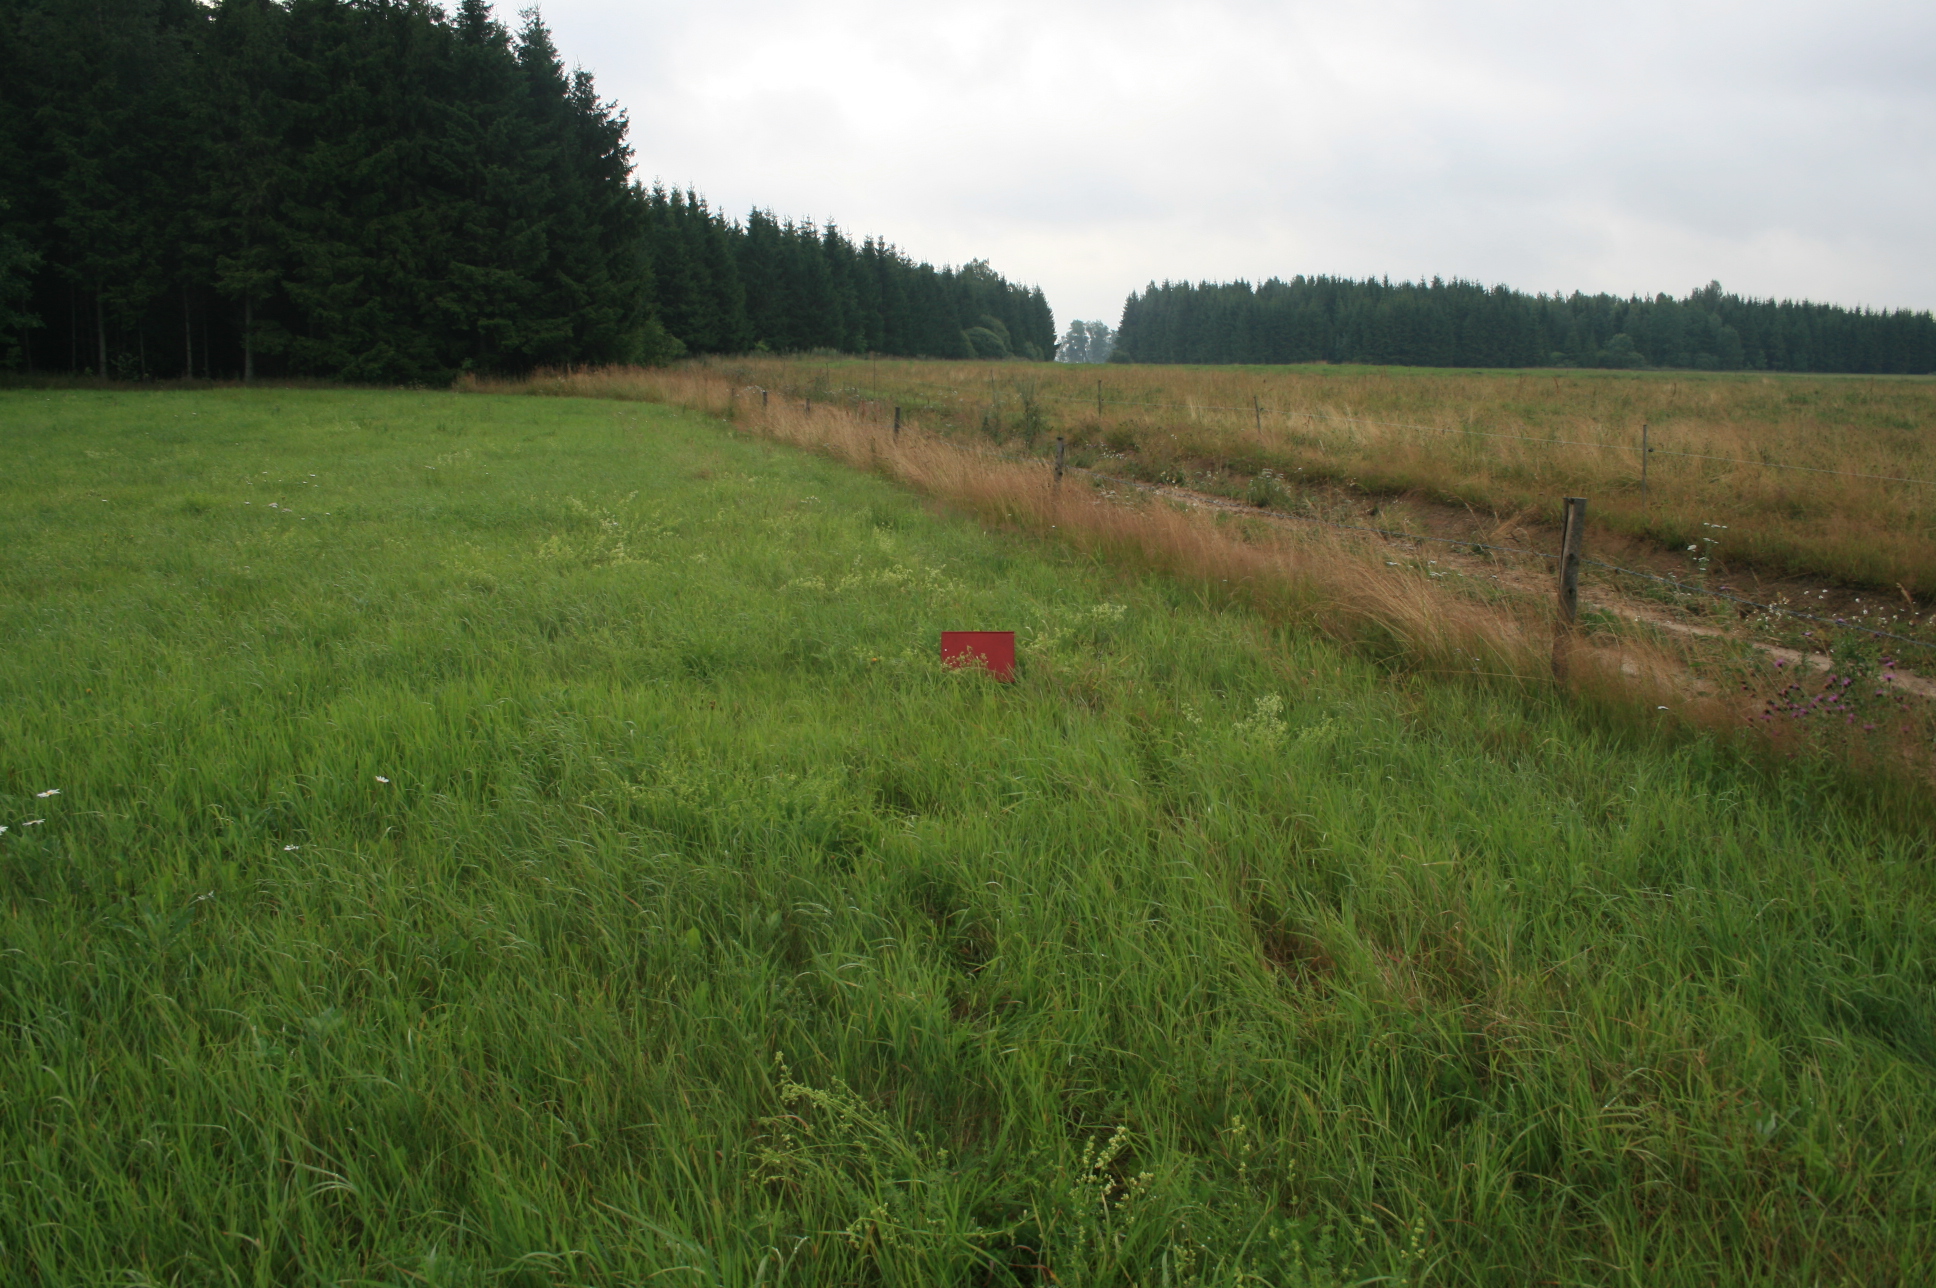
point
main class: Grassland
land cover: Grassland without tree/shrub cover
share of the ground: > 75 %
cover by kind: herbaceous plants 100 %
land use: Agriculture (excluding fallow land and kitchen gardens)
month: July
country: LT
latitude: 55.3707
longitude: 21.7739
